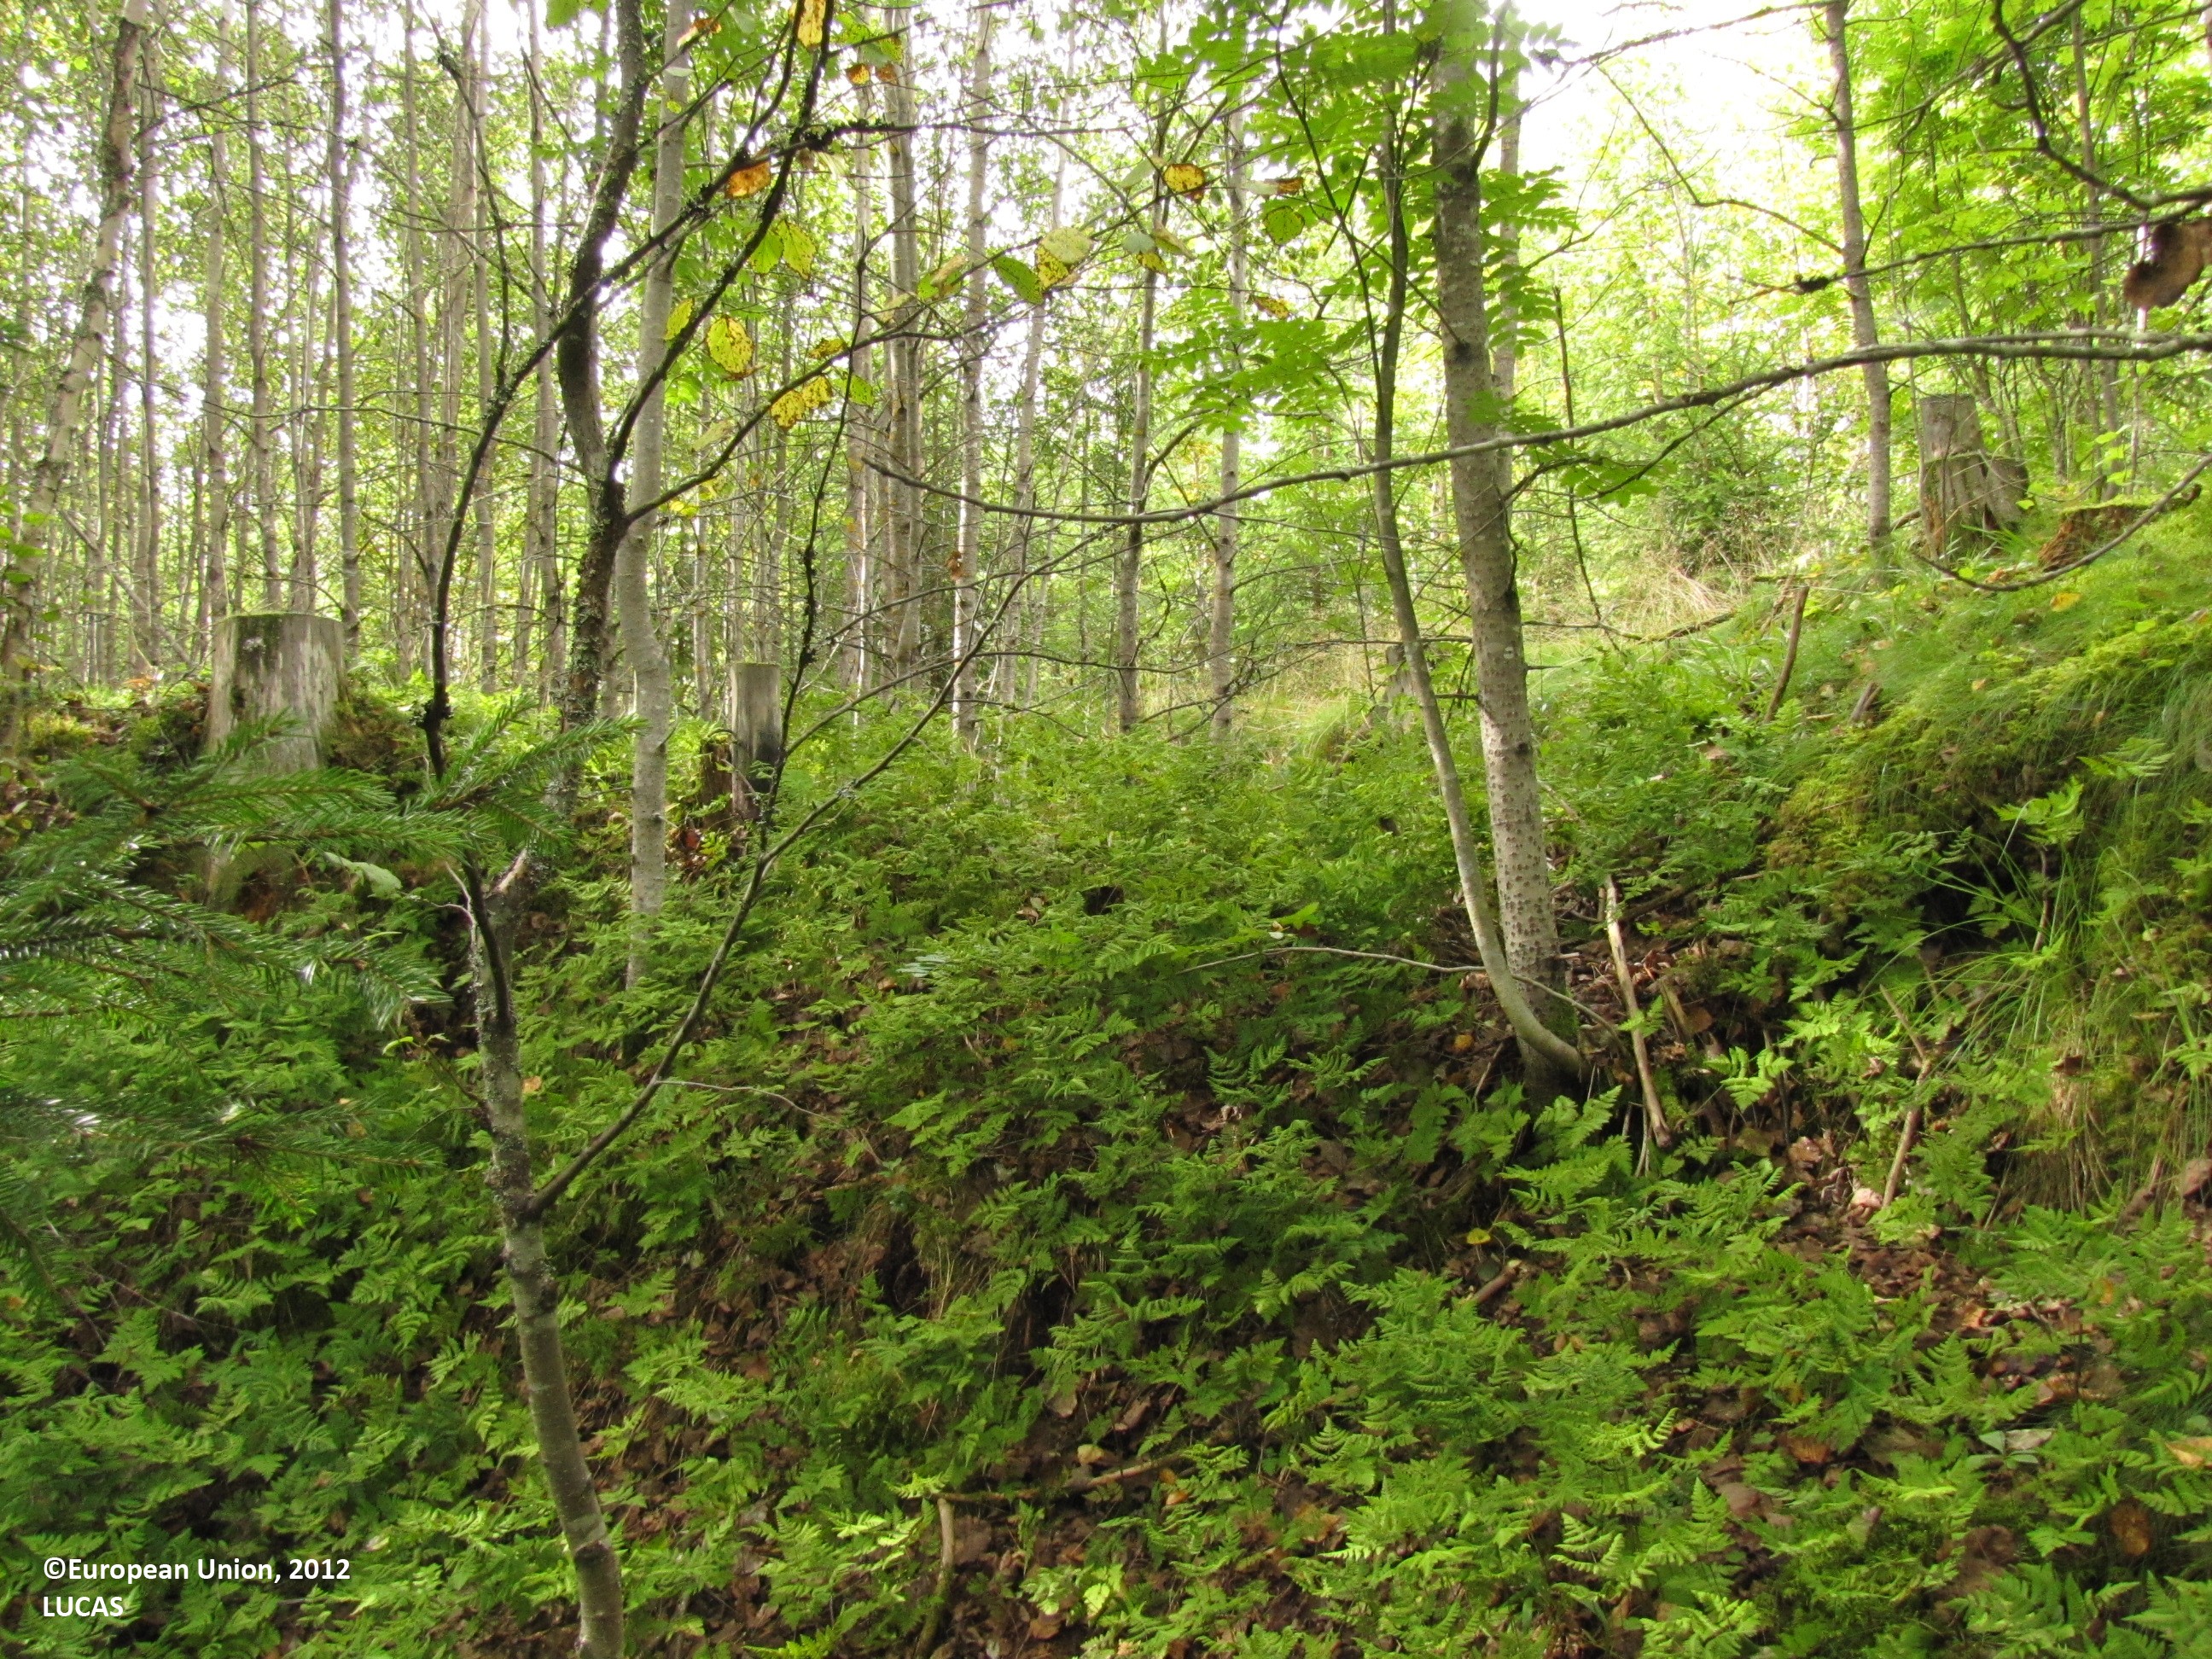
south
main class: Woodland
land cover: Broadleaved woodland
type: boreal forest
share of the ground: > 75 %
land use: Forestry
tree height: > 5 m
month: August
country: FI
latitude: 61.8858
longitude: 22.9455
